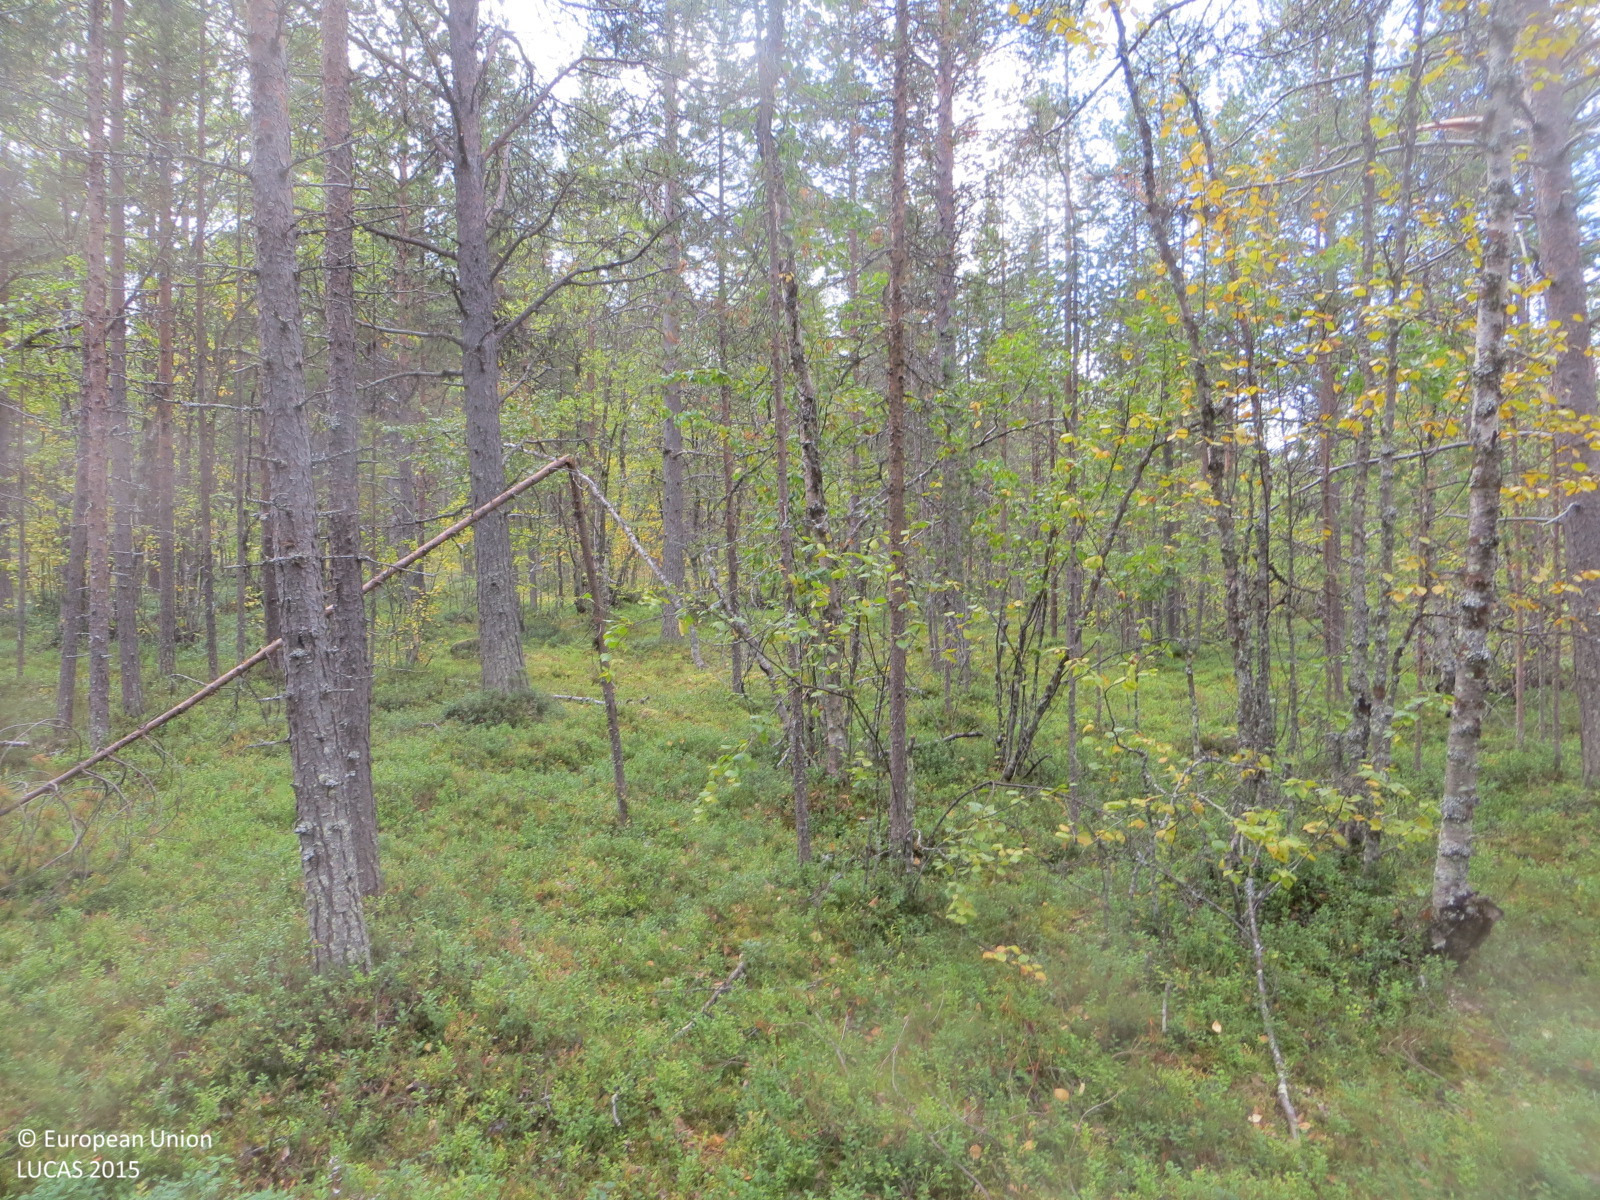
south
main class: Woodland
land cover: Pine dominated mixed woodland
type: boreal forest
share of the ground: 50 - 75 %
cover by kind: shrubs 50 %, coniferous forest trees 35 %, broadleaved forest trees 15 %
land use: Forestry
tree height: > 5 m
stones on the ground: < 10 %
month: September
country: FI
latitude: 68.3580
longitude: 24.1288
